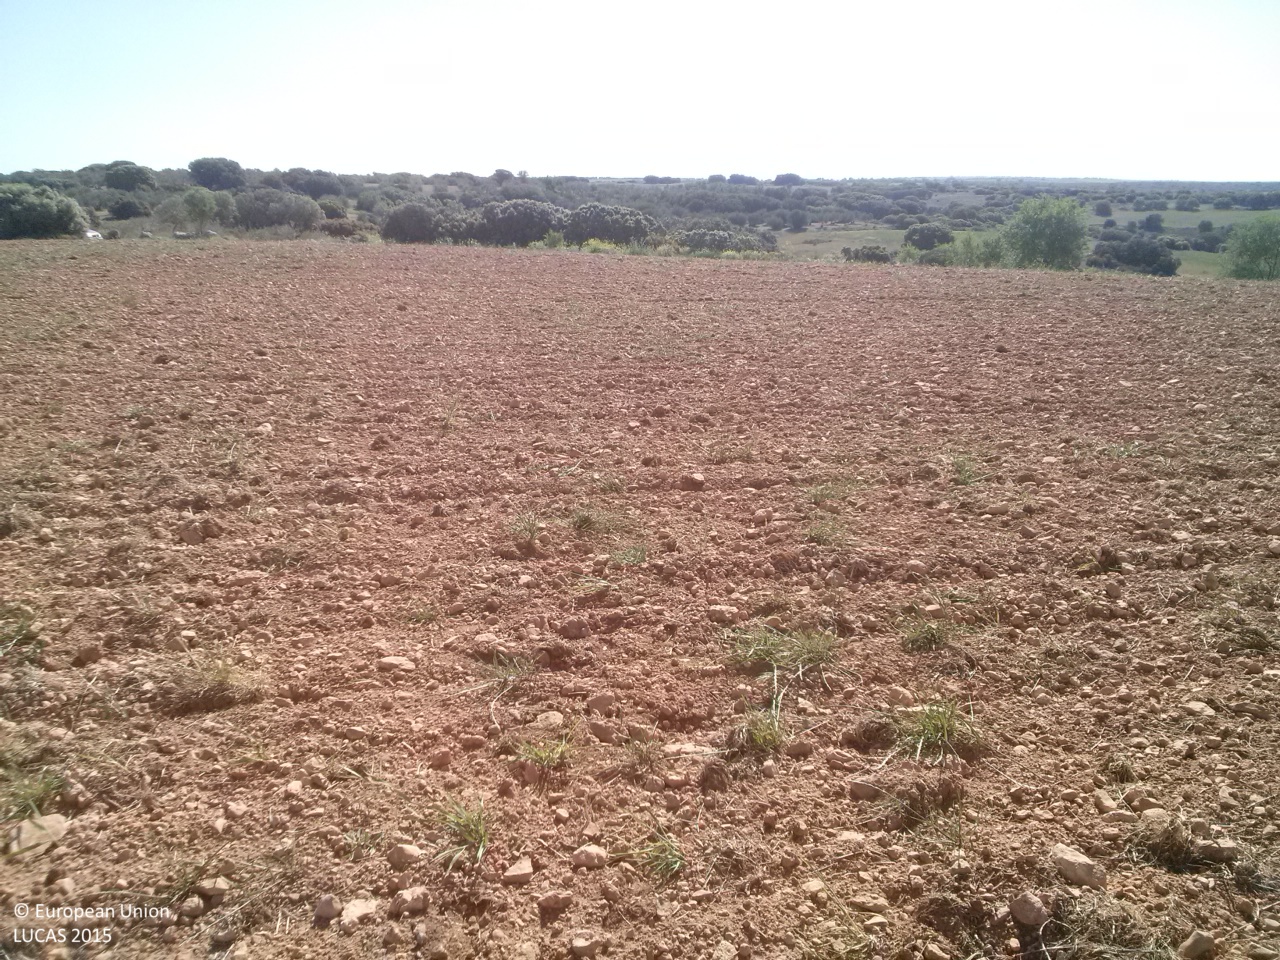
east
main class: Grassland
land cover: Spontaneously vegetated surfaces
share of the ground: 10 - 25 %
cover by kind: unconsolidated bare surface 85 %, herbaceous plants 15 %
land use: Fallow land
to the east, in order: Spontaneously vegetated surfaces; Grass margins; Tracks; Grass margins; Broadleaved woodland; Grassland without tree/shrub cover; Olive groves
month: May
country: ES
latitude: 39.8468
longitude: -2.7935
